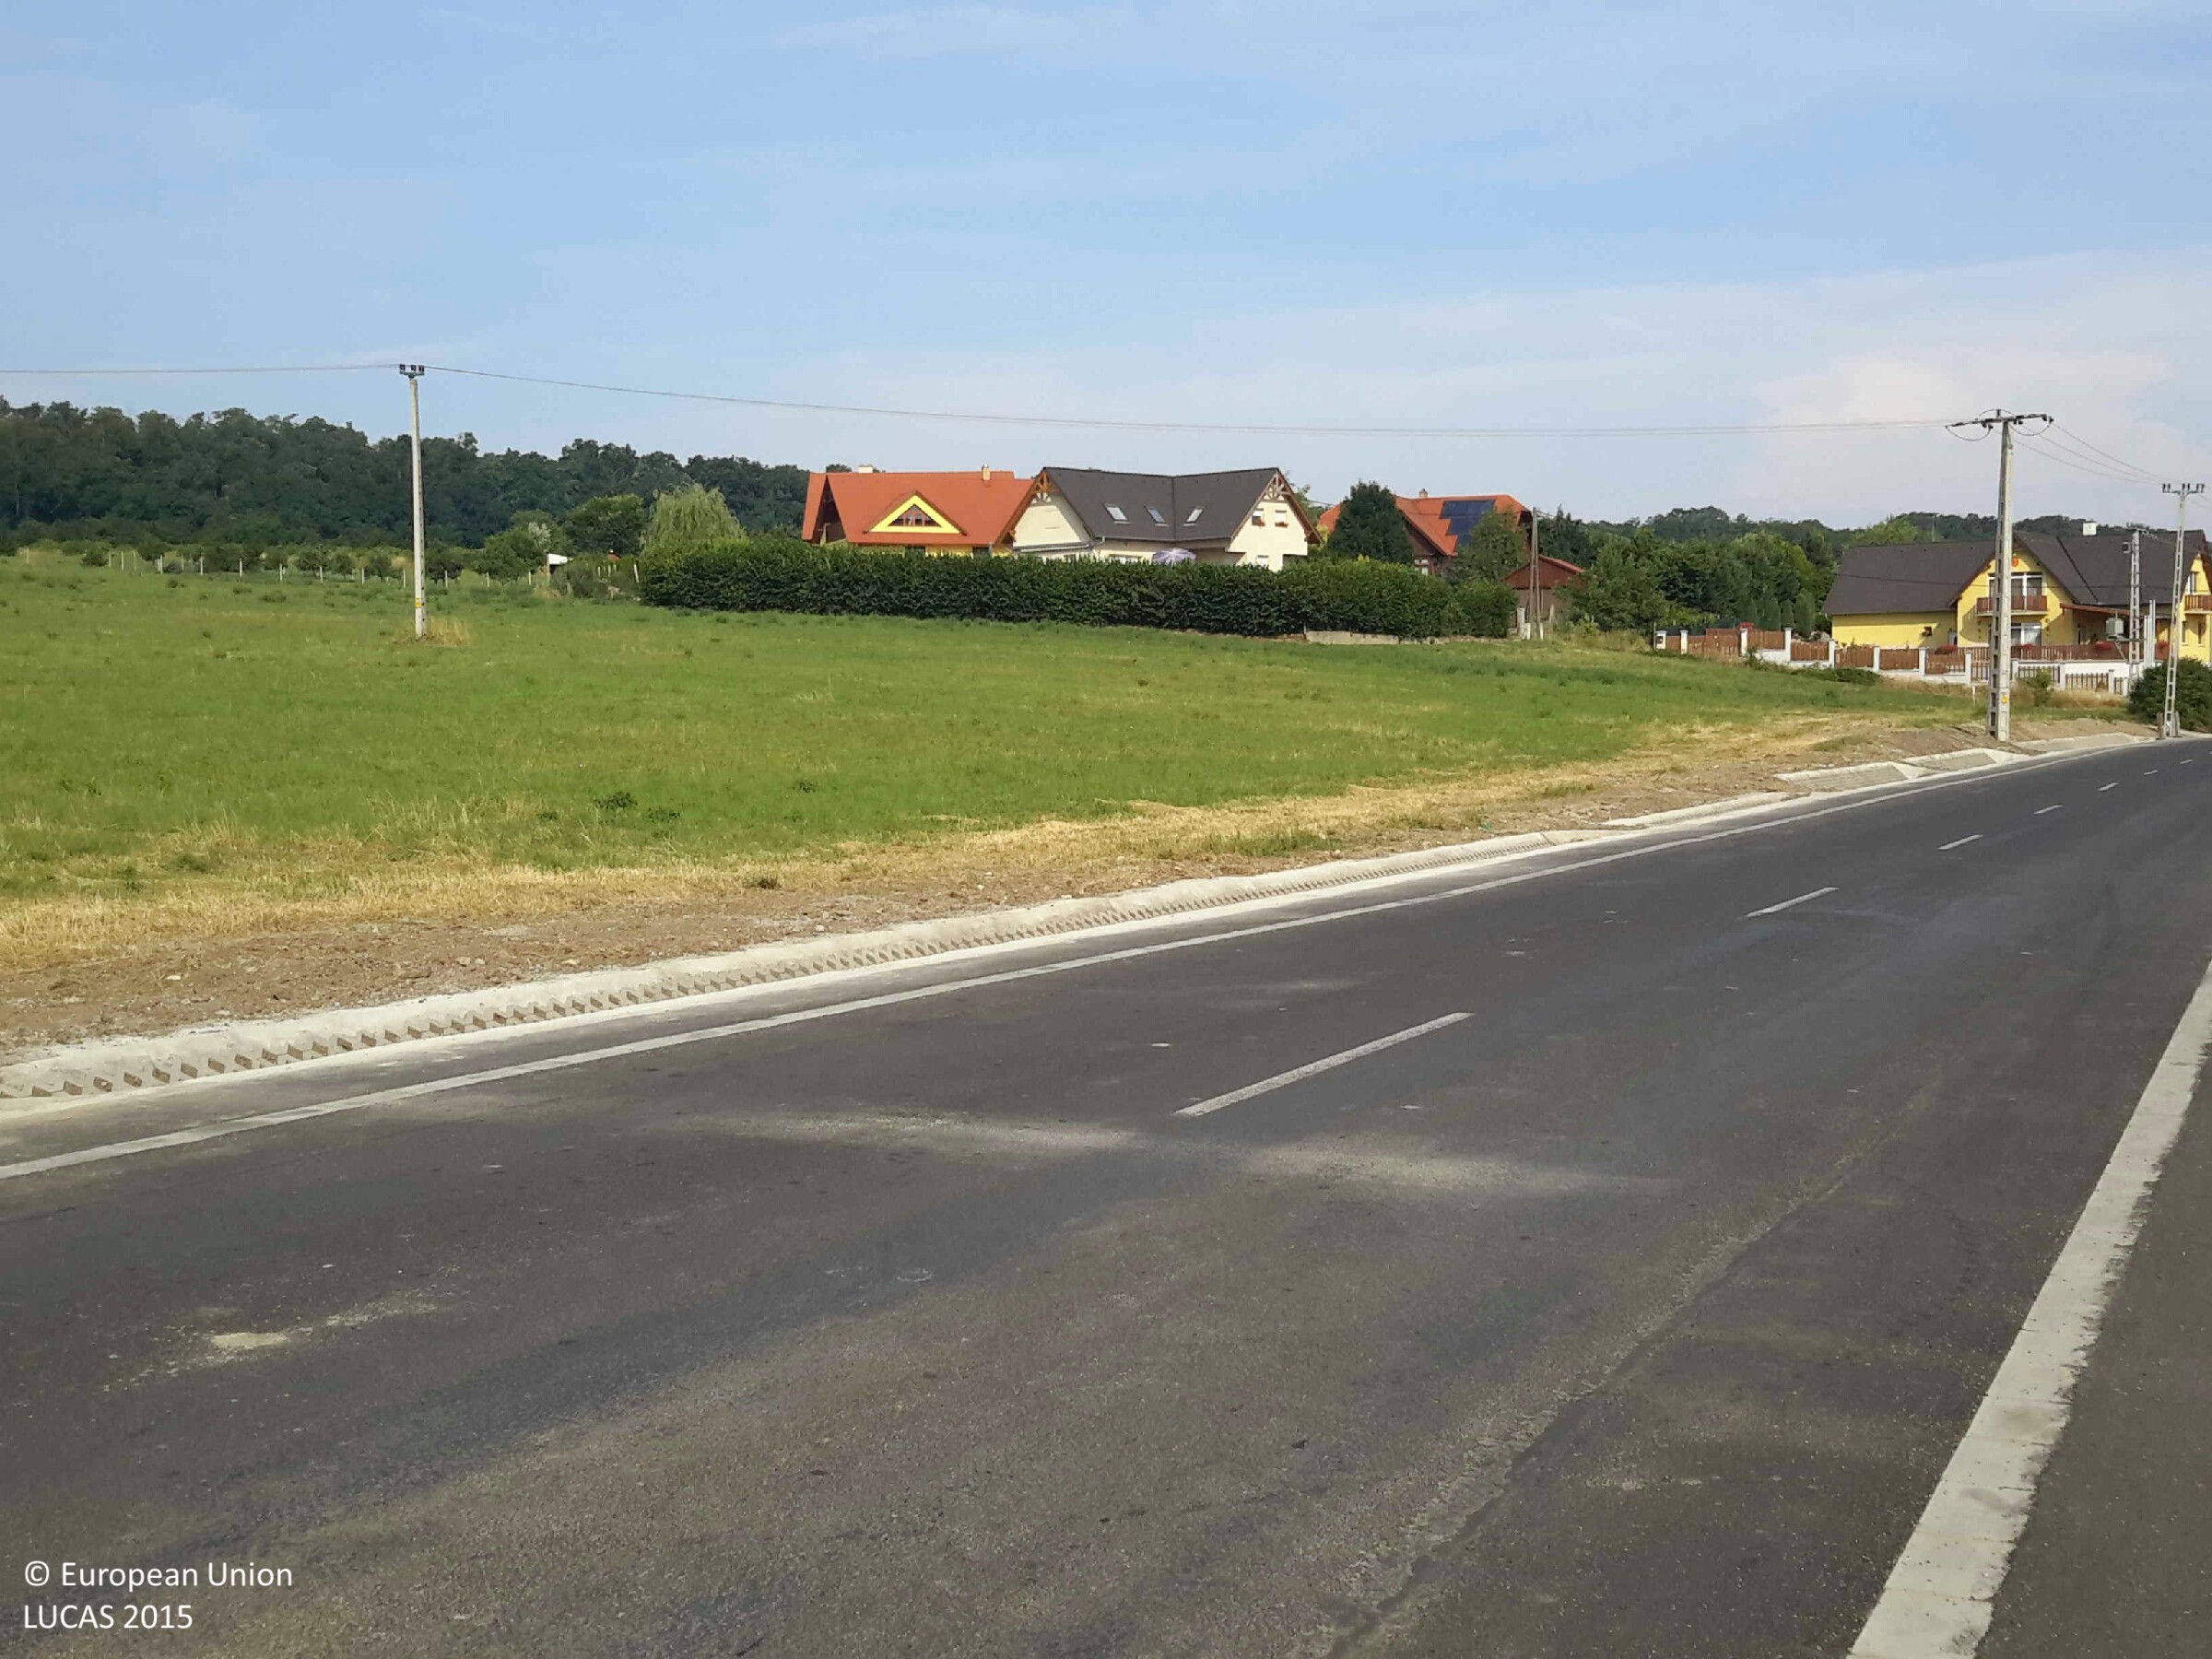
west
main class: Cropland
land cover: Vineyards
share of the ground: < 10 %
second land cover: Other bare soil
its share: > 75 %
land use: Agriculture (excluding fallow land and kitchen gardens)
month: July
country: HU
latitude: 47.6421
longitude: 16.6736
